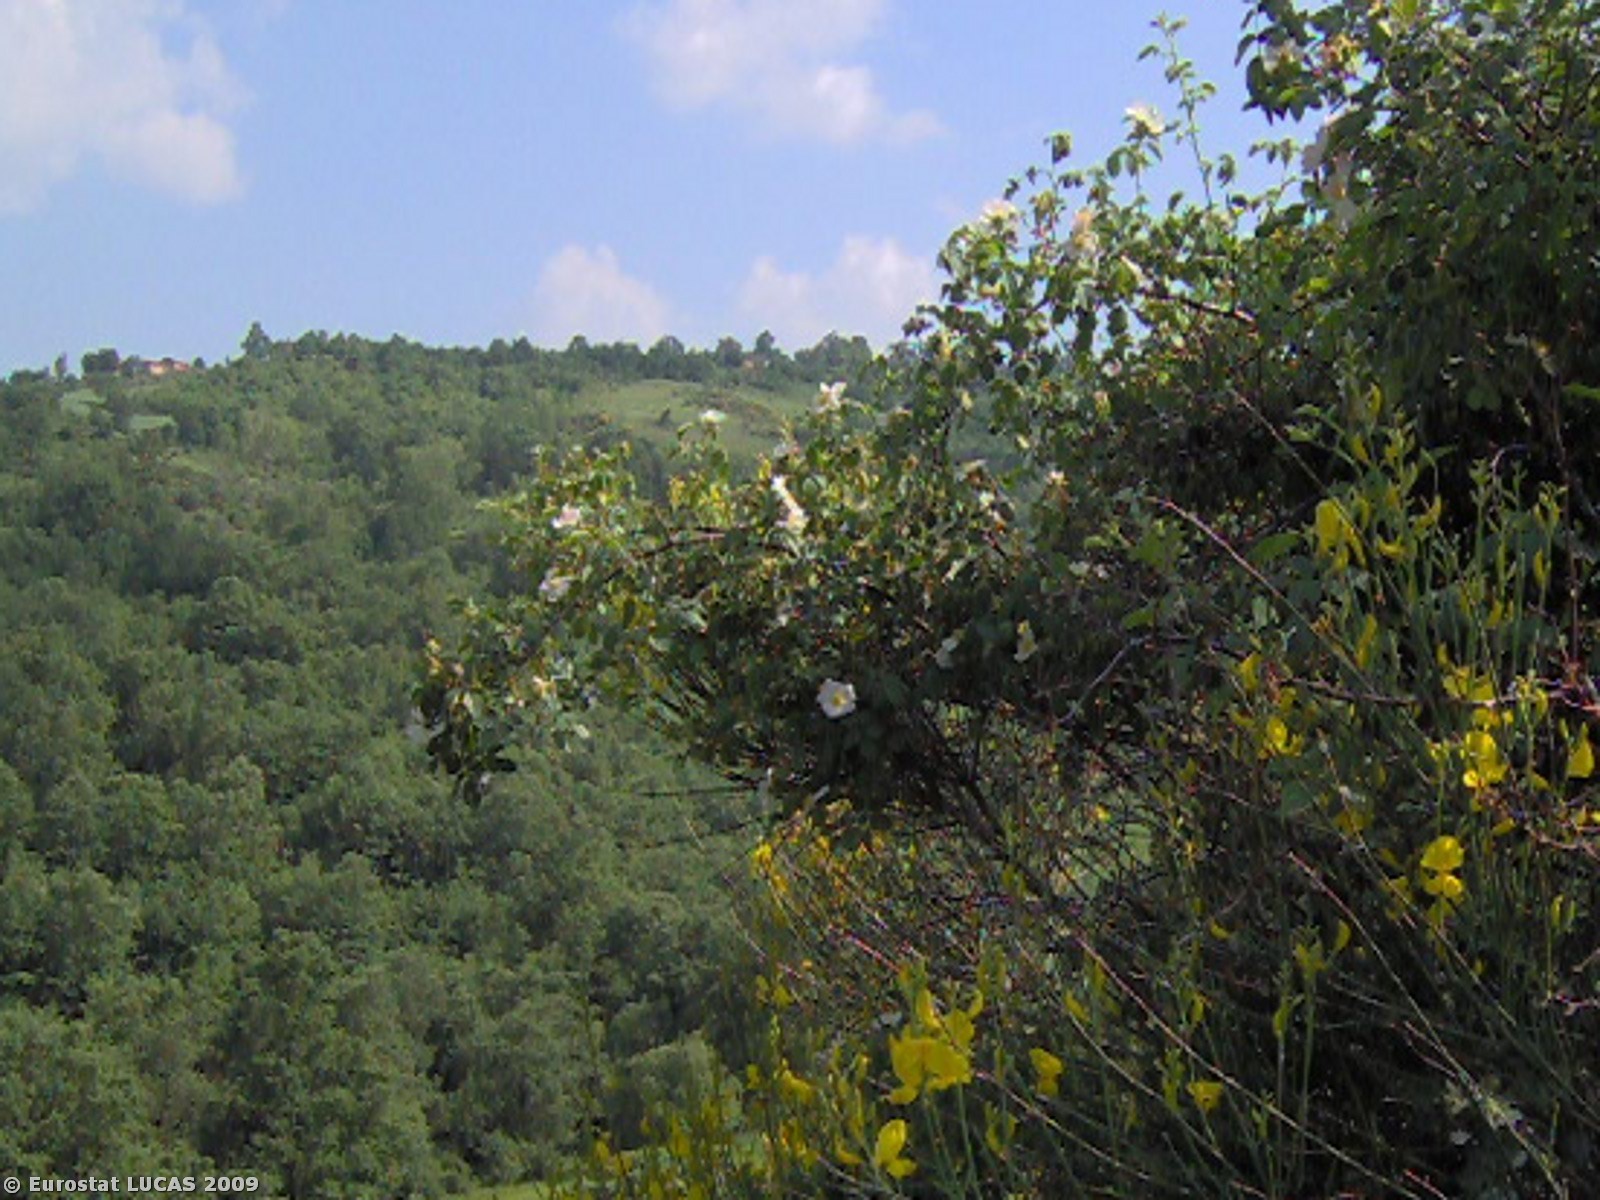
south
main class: Grassland
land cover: Grassland without tree/shrub cover
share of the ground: > 75 %
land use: Agriculture (excluding fallow land and kitchen gardens)
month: May
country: IT
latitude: 40.8333
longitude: 15.5881
